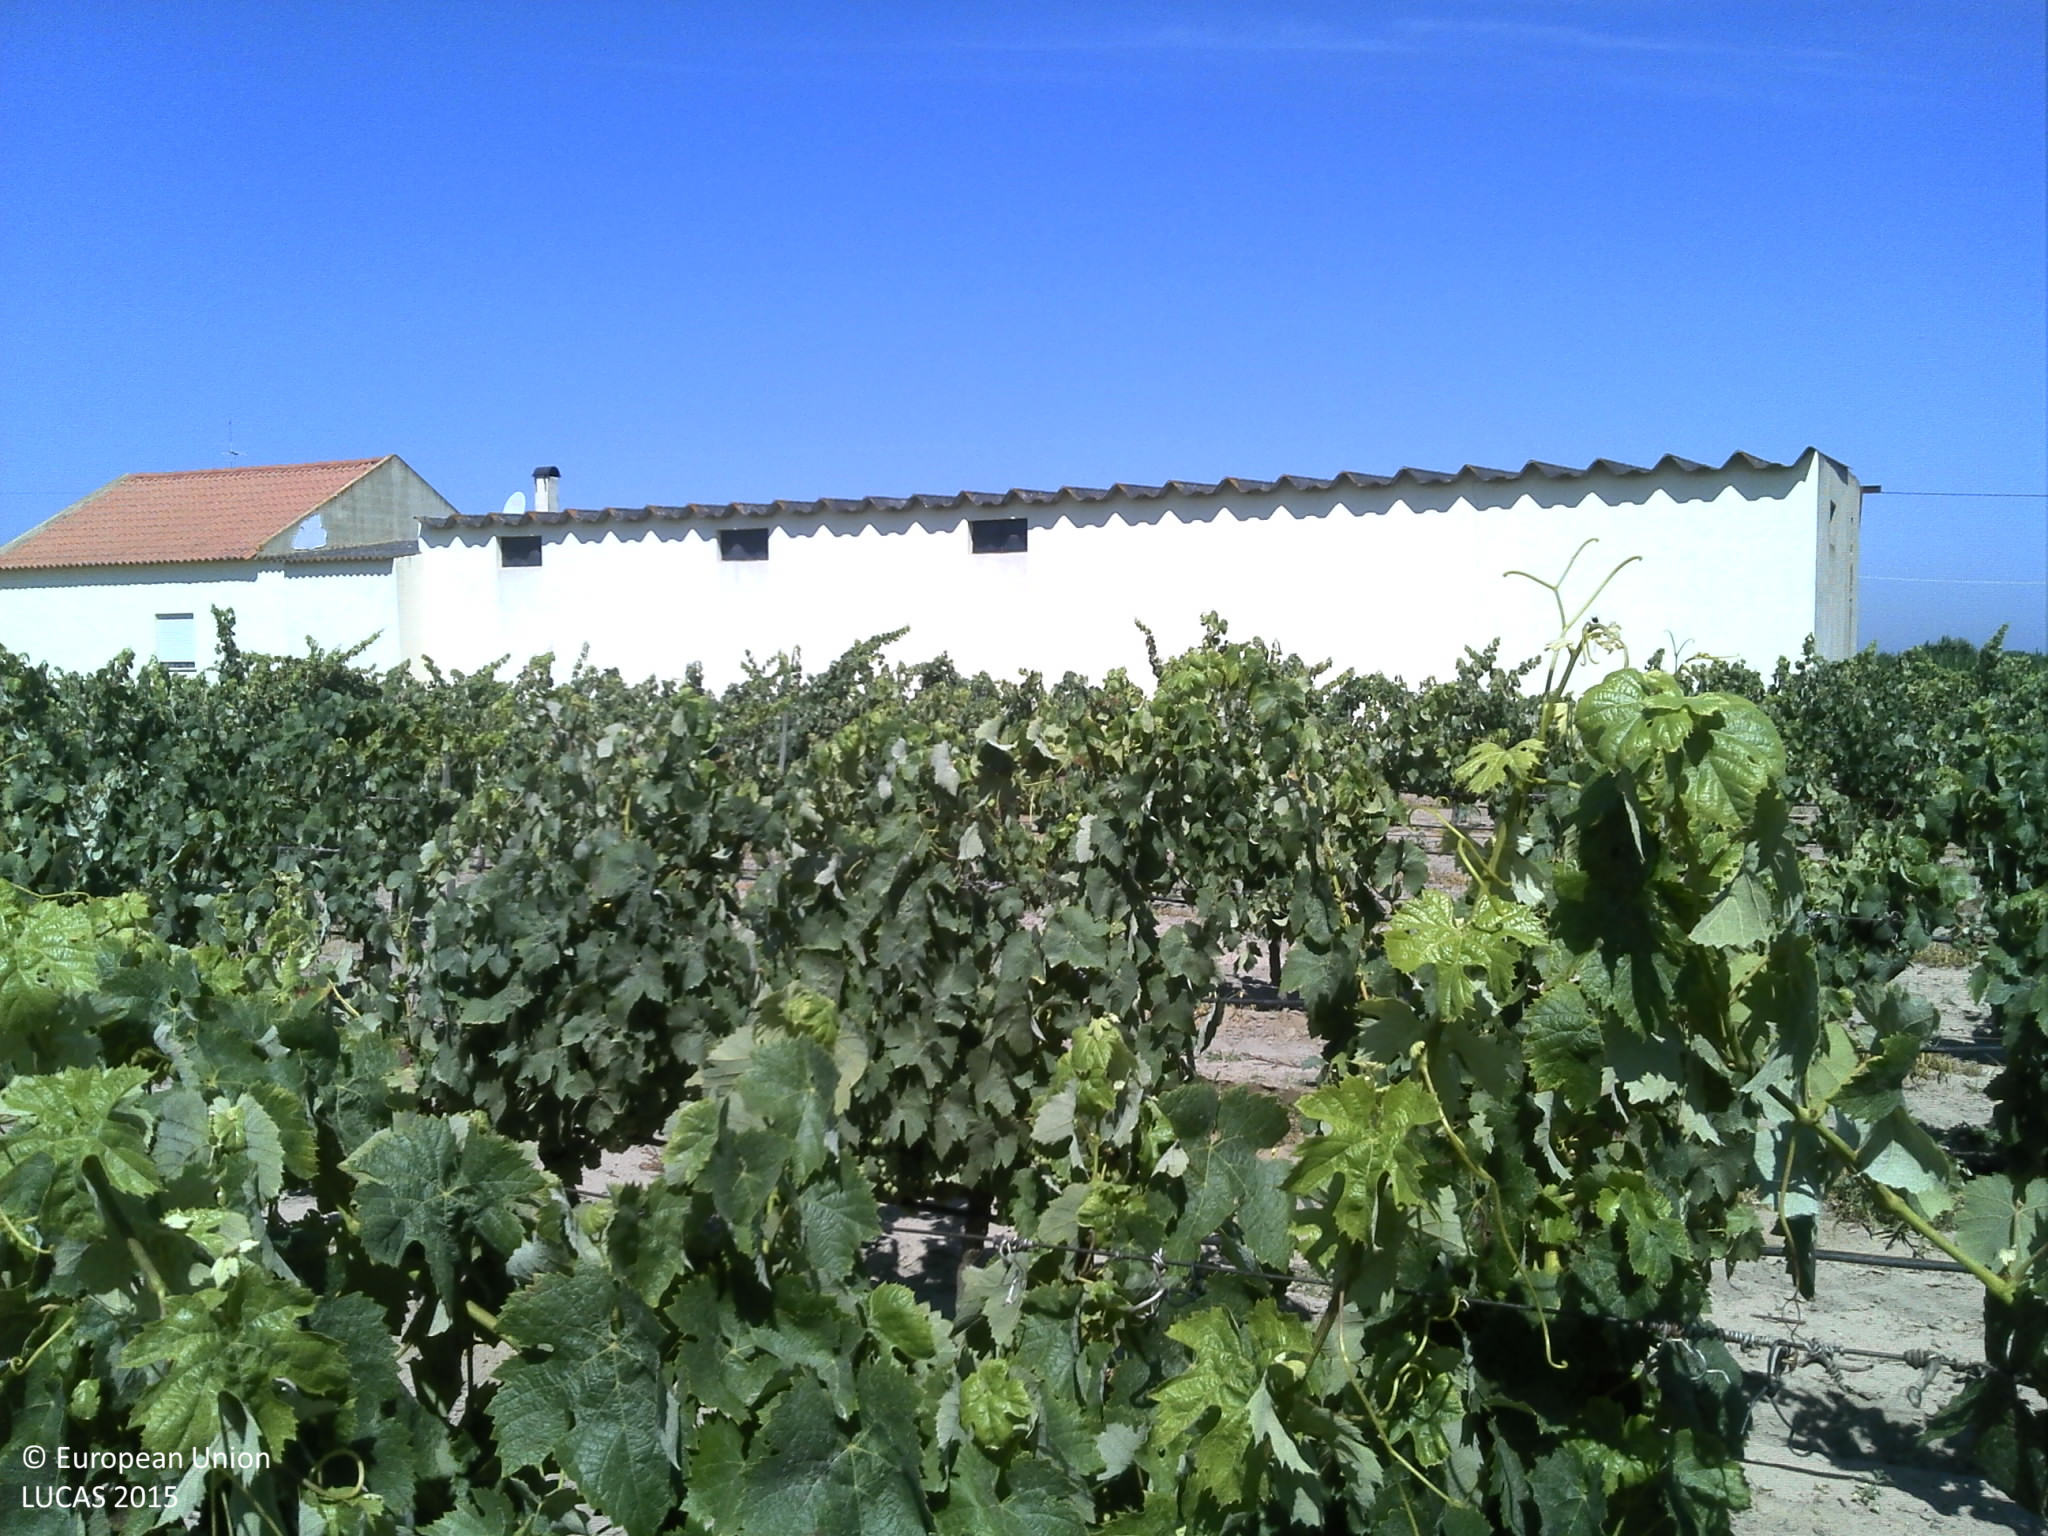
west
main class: Cropland
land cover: Vineyards
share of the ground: 25 - 50 %
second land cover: Other bare soil
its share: > 75 %
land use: Agriculture (excluding fallow land and kitchen gardens)
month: June
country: PT
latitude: 39.1258
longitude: -8.6582
